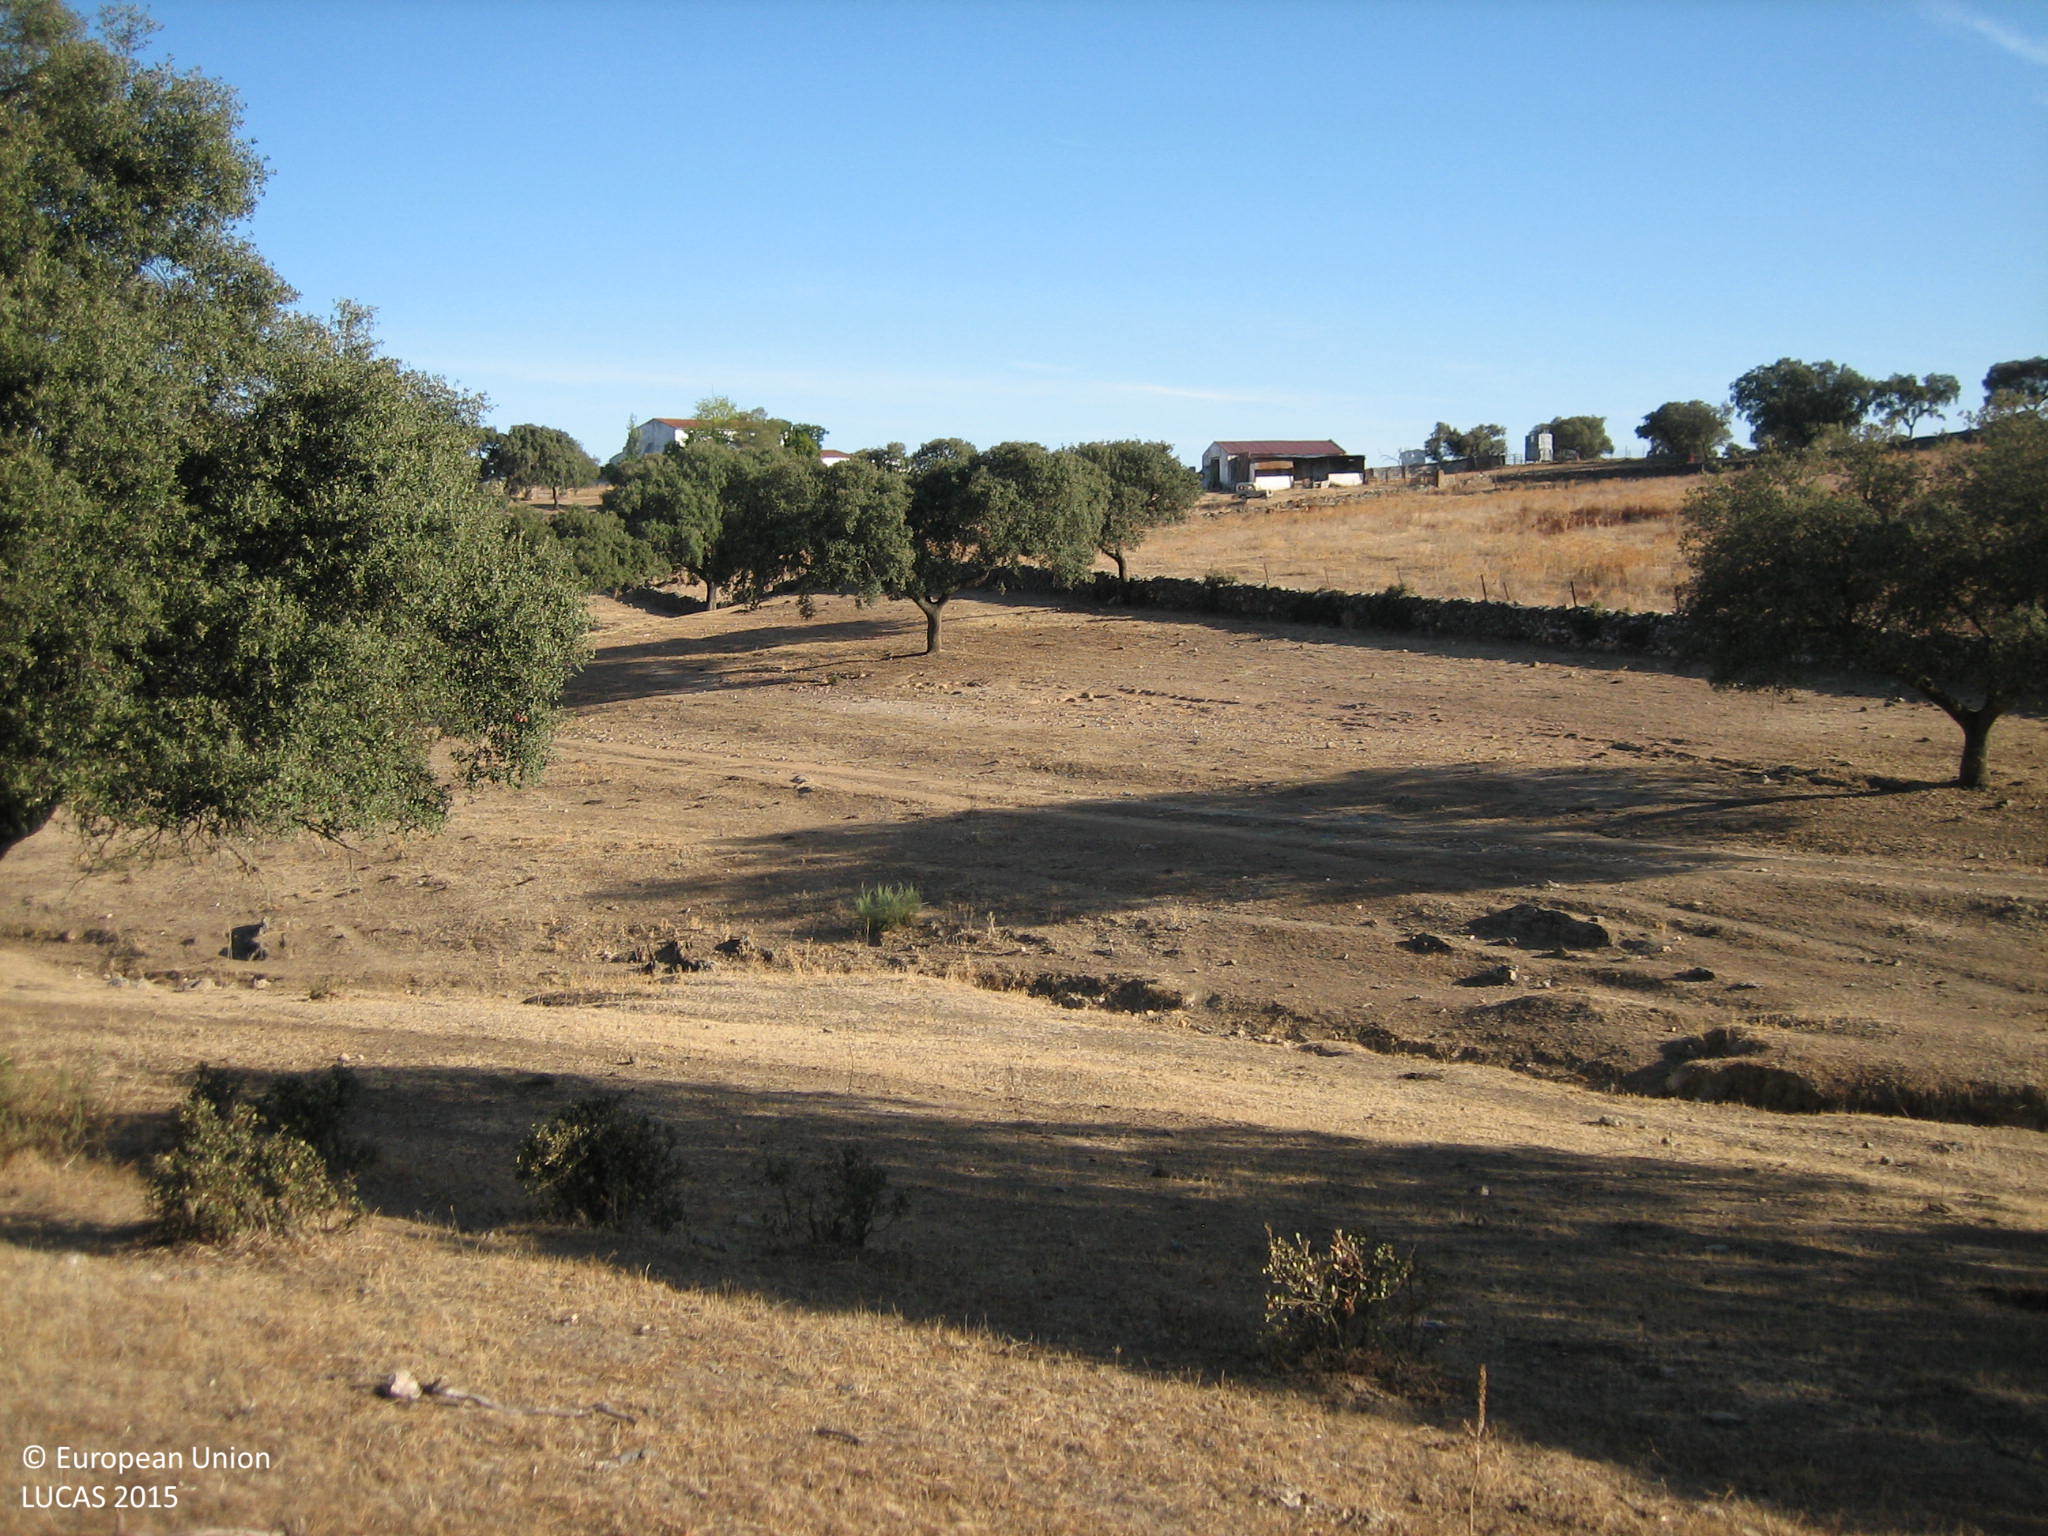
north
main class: Woodland
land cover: Broadleaved woodland
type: broadleaved evergreen forest
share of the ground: 25 - 50 %
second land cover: Grassland without tree/shrub cover
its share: 25 - 50 %
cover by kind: broadleaved forest trees 40 %, herbaceous plants 30 %, unconsolidated bare surface 30 %
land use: Forestry
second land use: Agriculture (excluding fallow land and kitchen gardens)
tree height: > 5 m
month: August
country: ES
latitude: 38.5725
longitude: -7.1823
